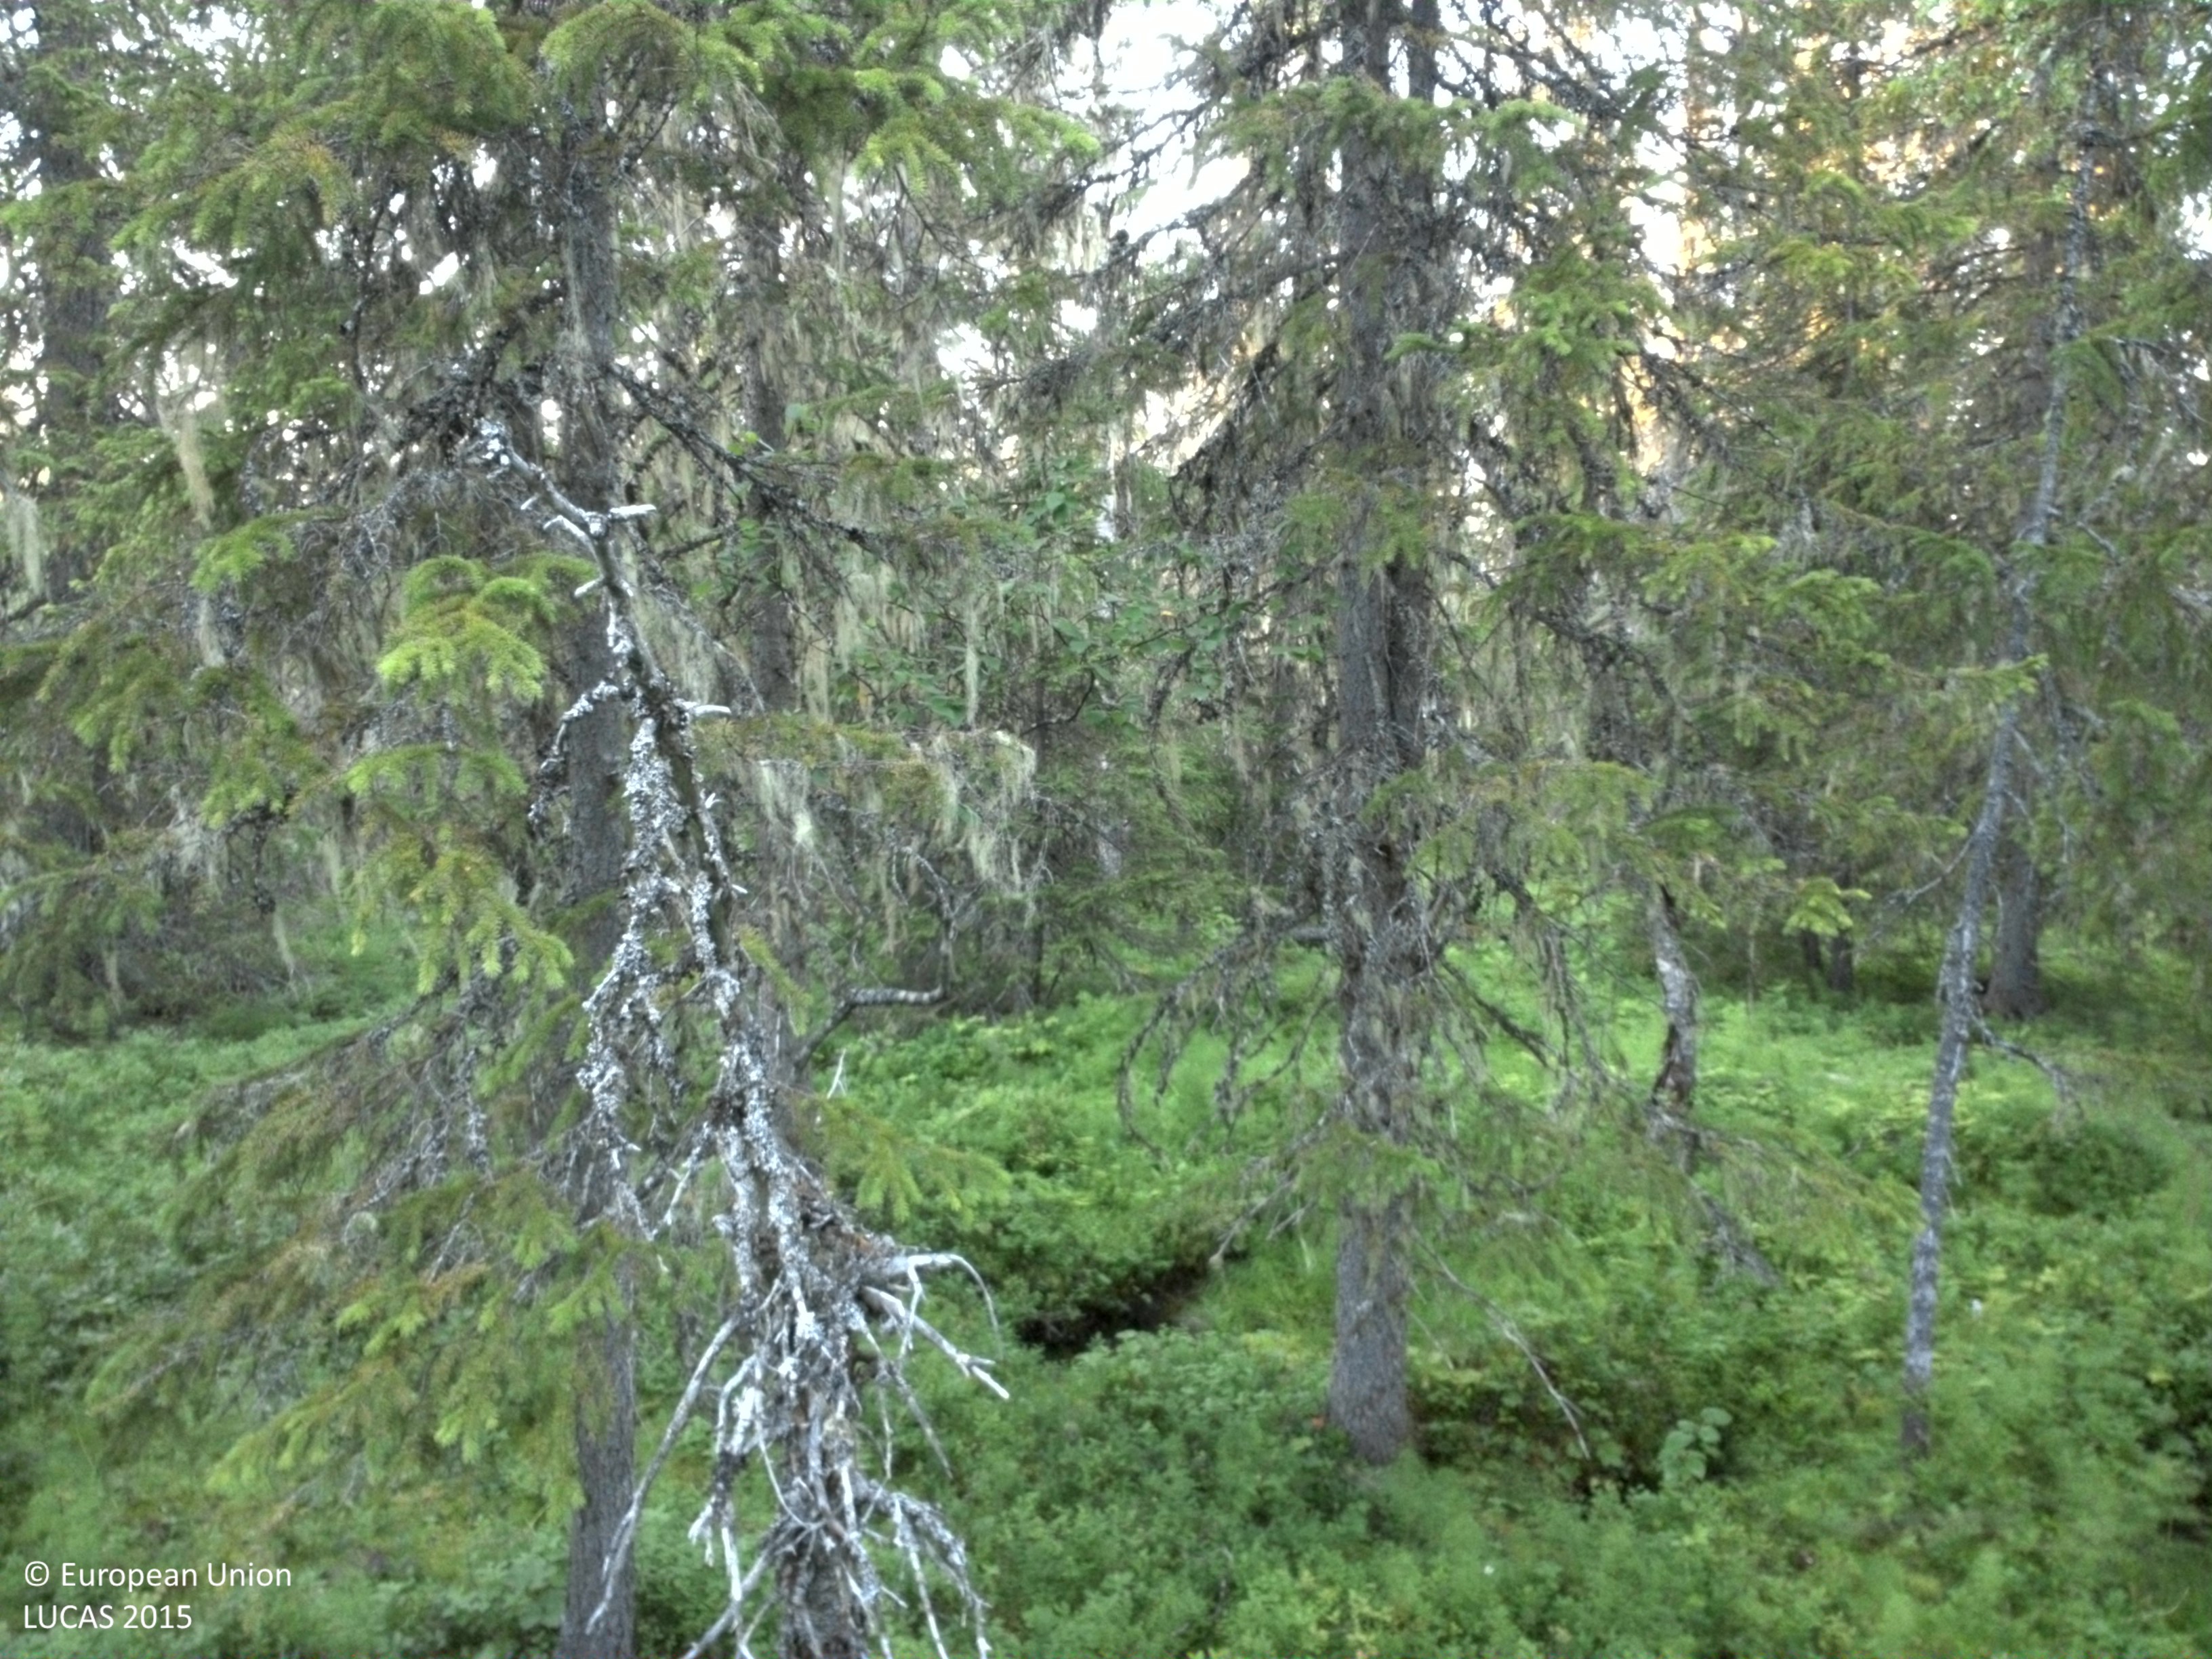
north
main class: Woodland
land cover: Spruce dominated coniferous woodland
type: boreal forest
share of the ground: 25 - 50 %
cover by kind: coniferous forest trees 30 %, herbaceous plants 25 %, shrubs 20 %, lichens and mosses 20 %, broadleaved forest trees 5 %
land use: Forestry
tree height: > 5 m
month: August
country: SE
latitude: 64.7963
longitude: 15.8815
